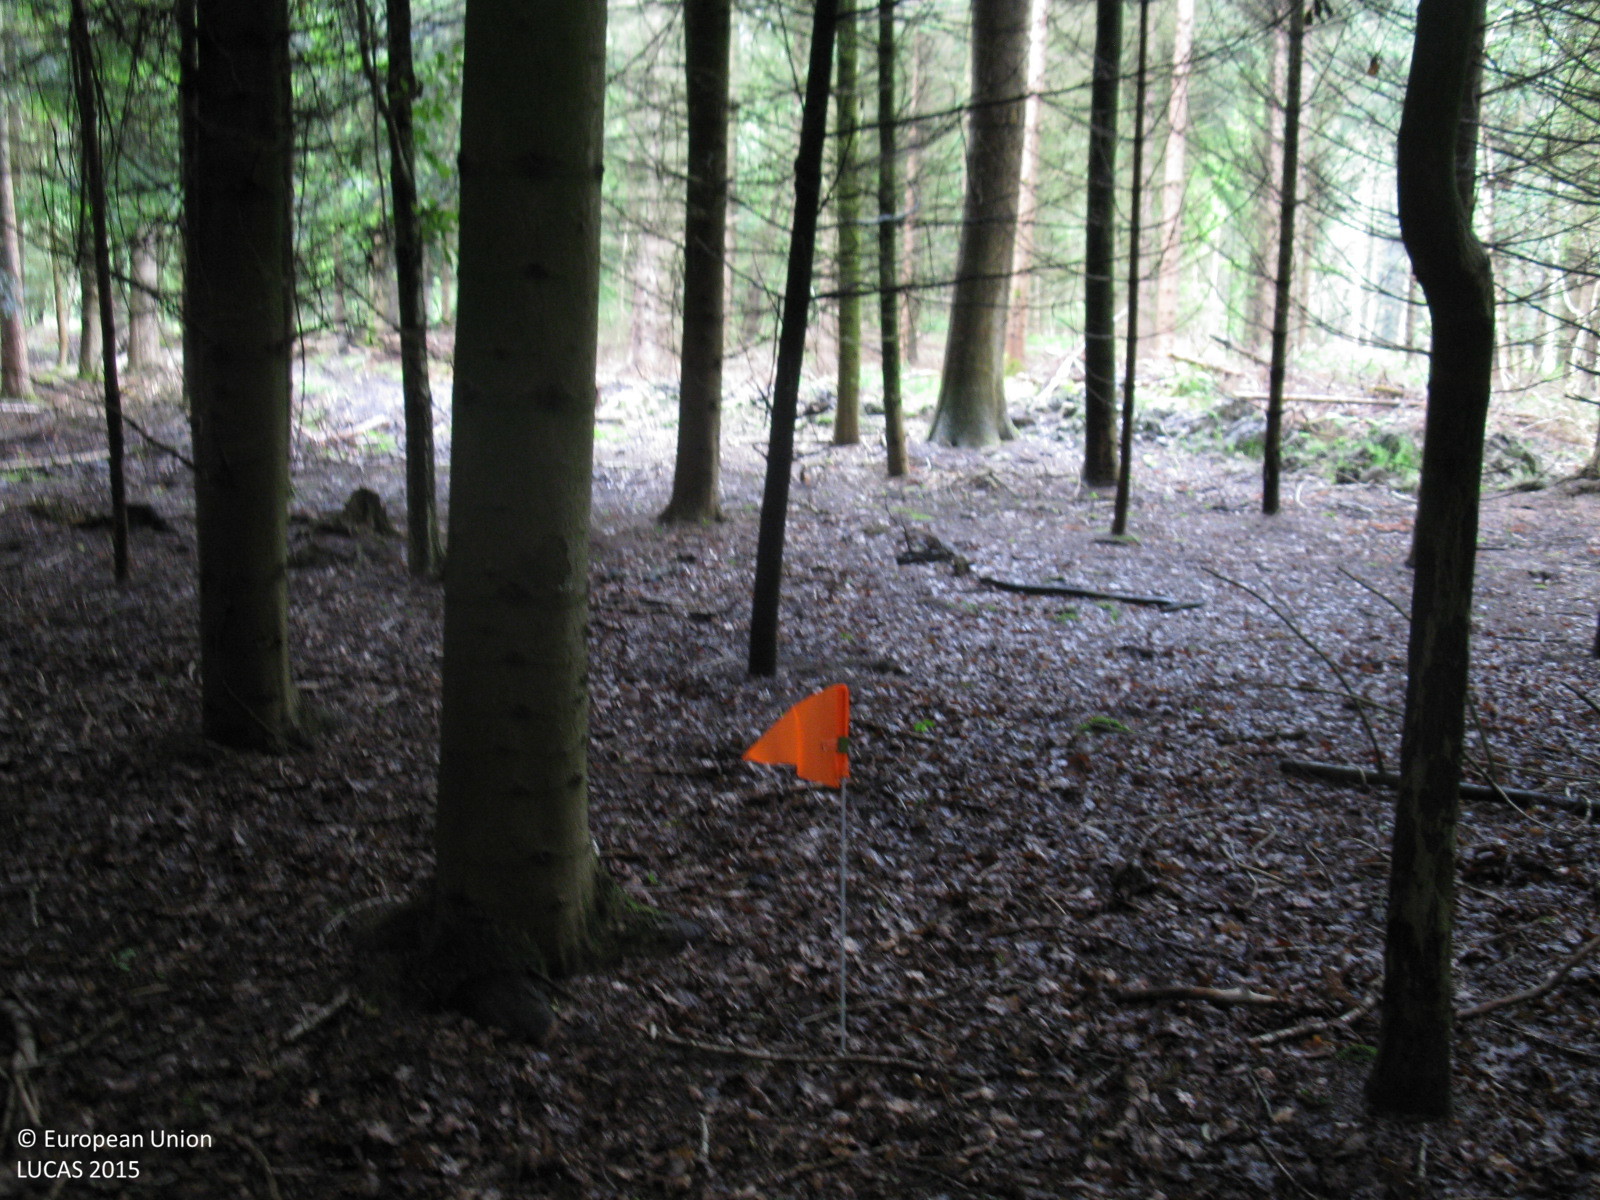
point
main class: Woodland
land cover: Spruce dominated mixed woodland
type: hemiboreal forest and nemoral coniferous forest and mixed broadleaved-coniferous forest
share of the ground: > 75 %
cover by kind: coniferous forest trees 70 %, broadleaved forest trees 30 %
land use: Forestry
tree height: > 5 m
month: June
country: DE
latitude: 53.6228
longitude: 7.2641
